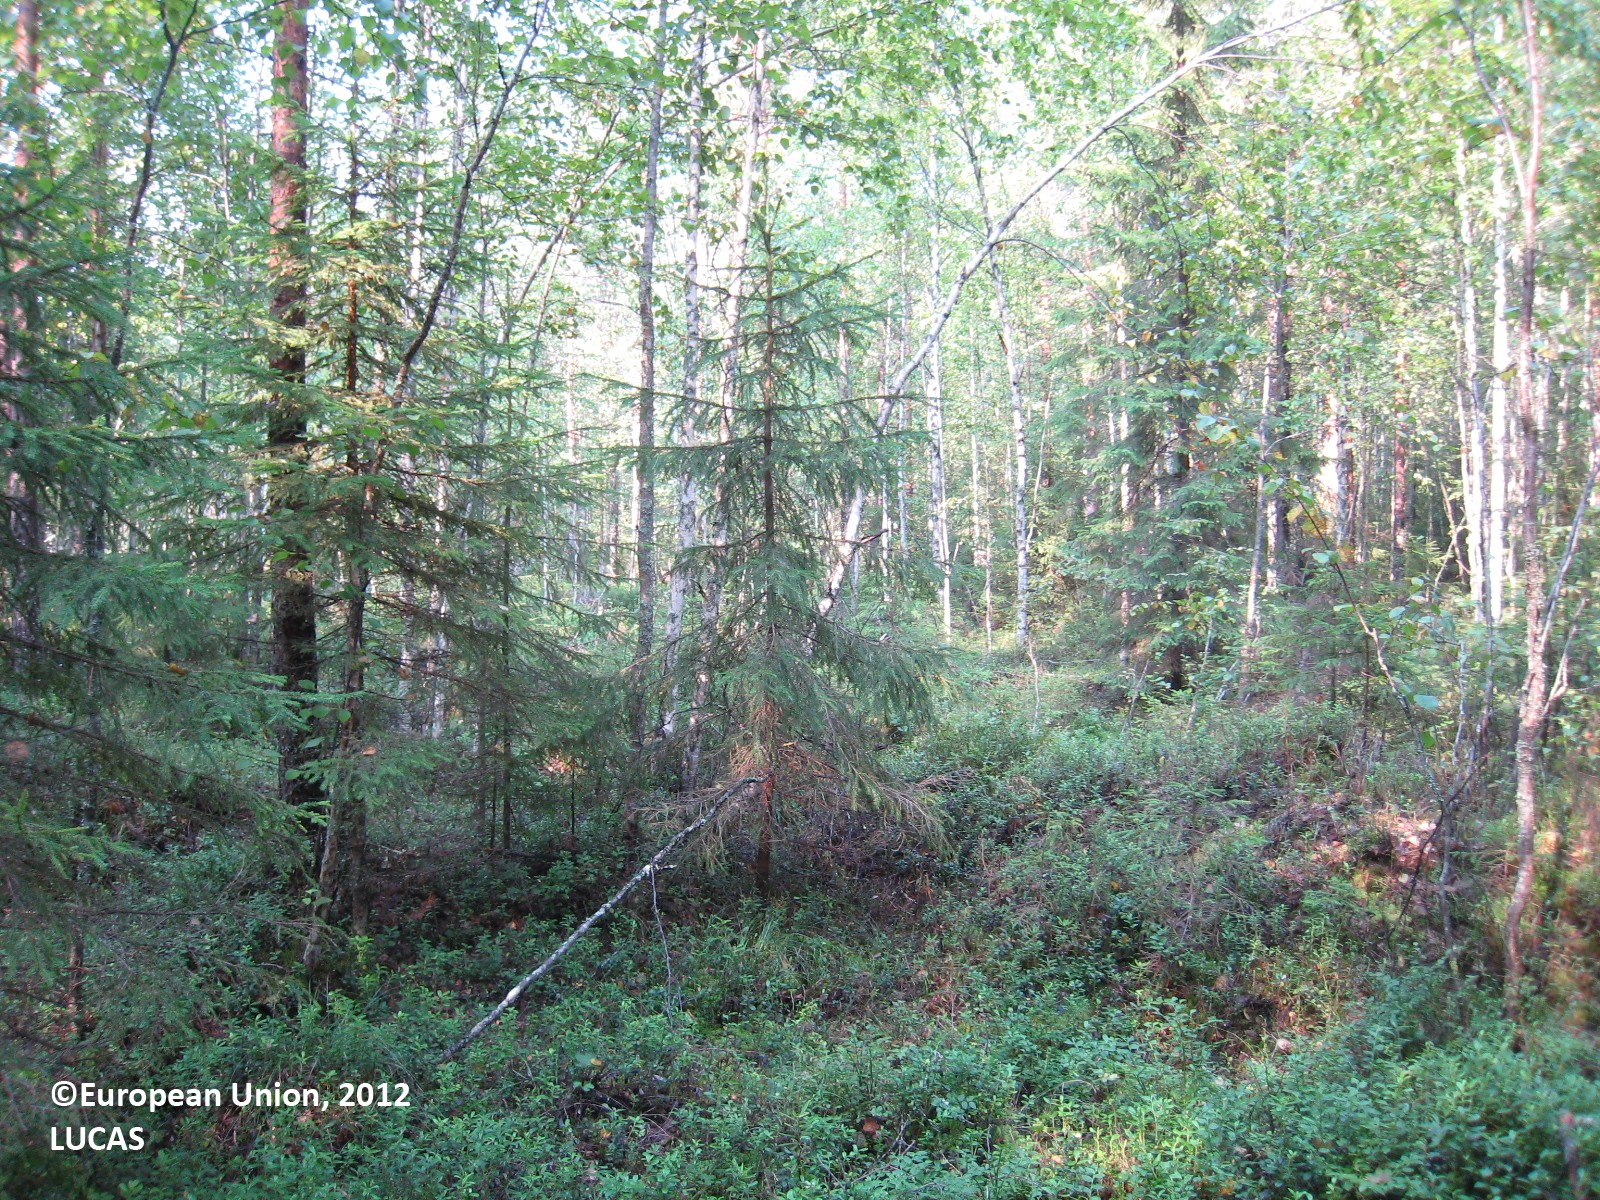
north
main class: Woodland
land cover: Other mixed woodland
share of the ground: > 75 %
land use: Forestry
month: July
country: FI
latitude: 62.4328
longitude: 27.3034
